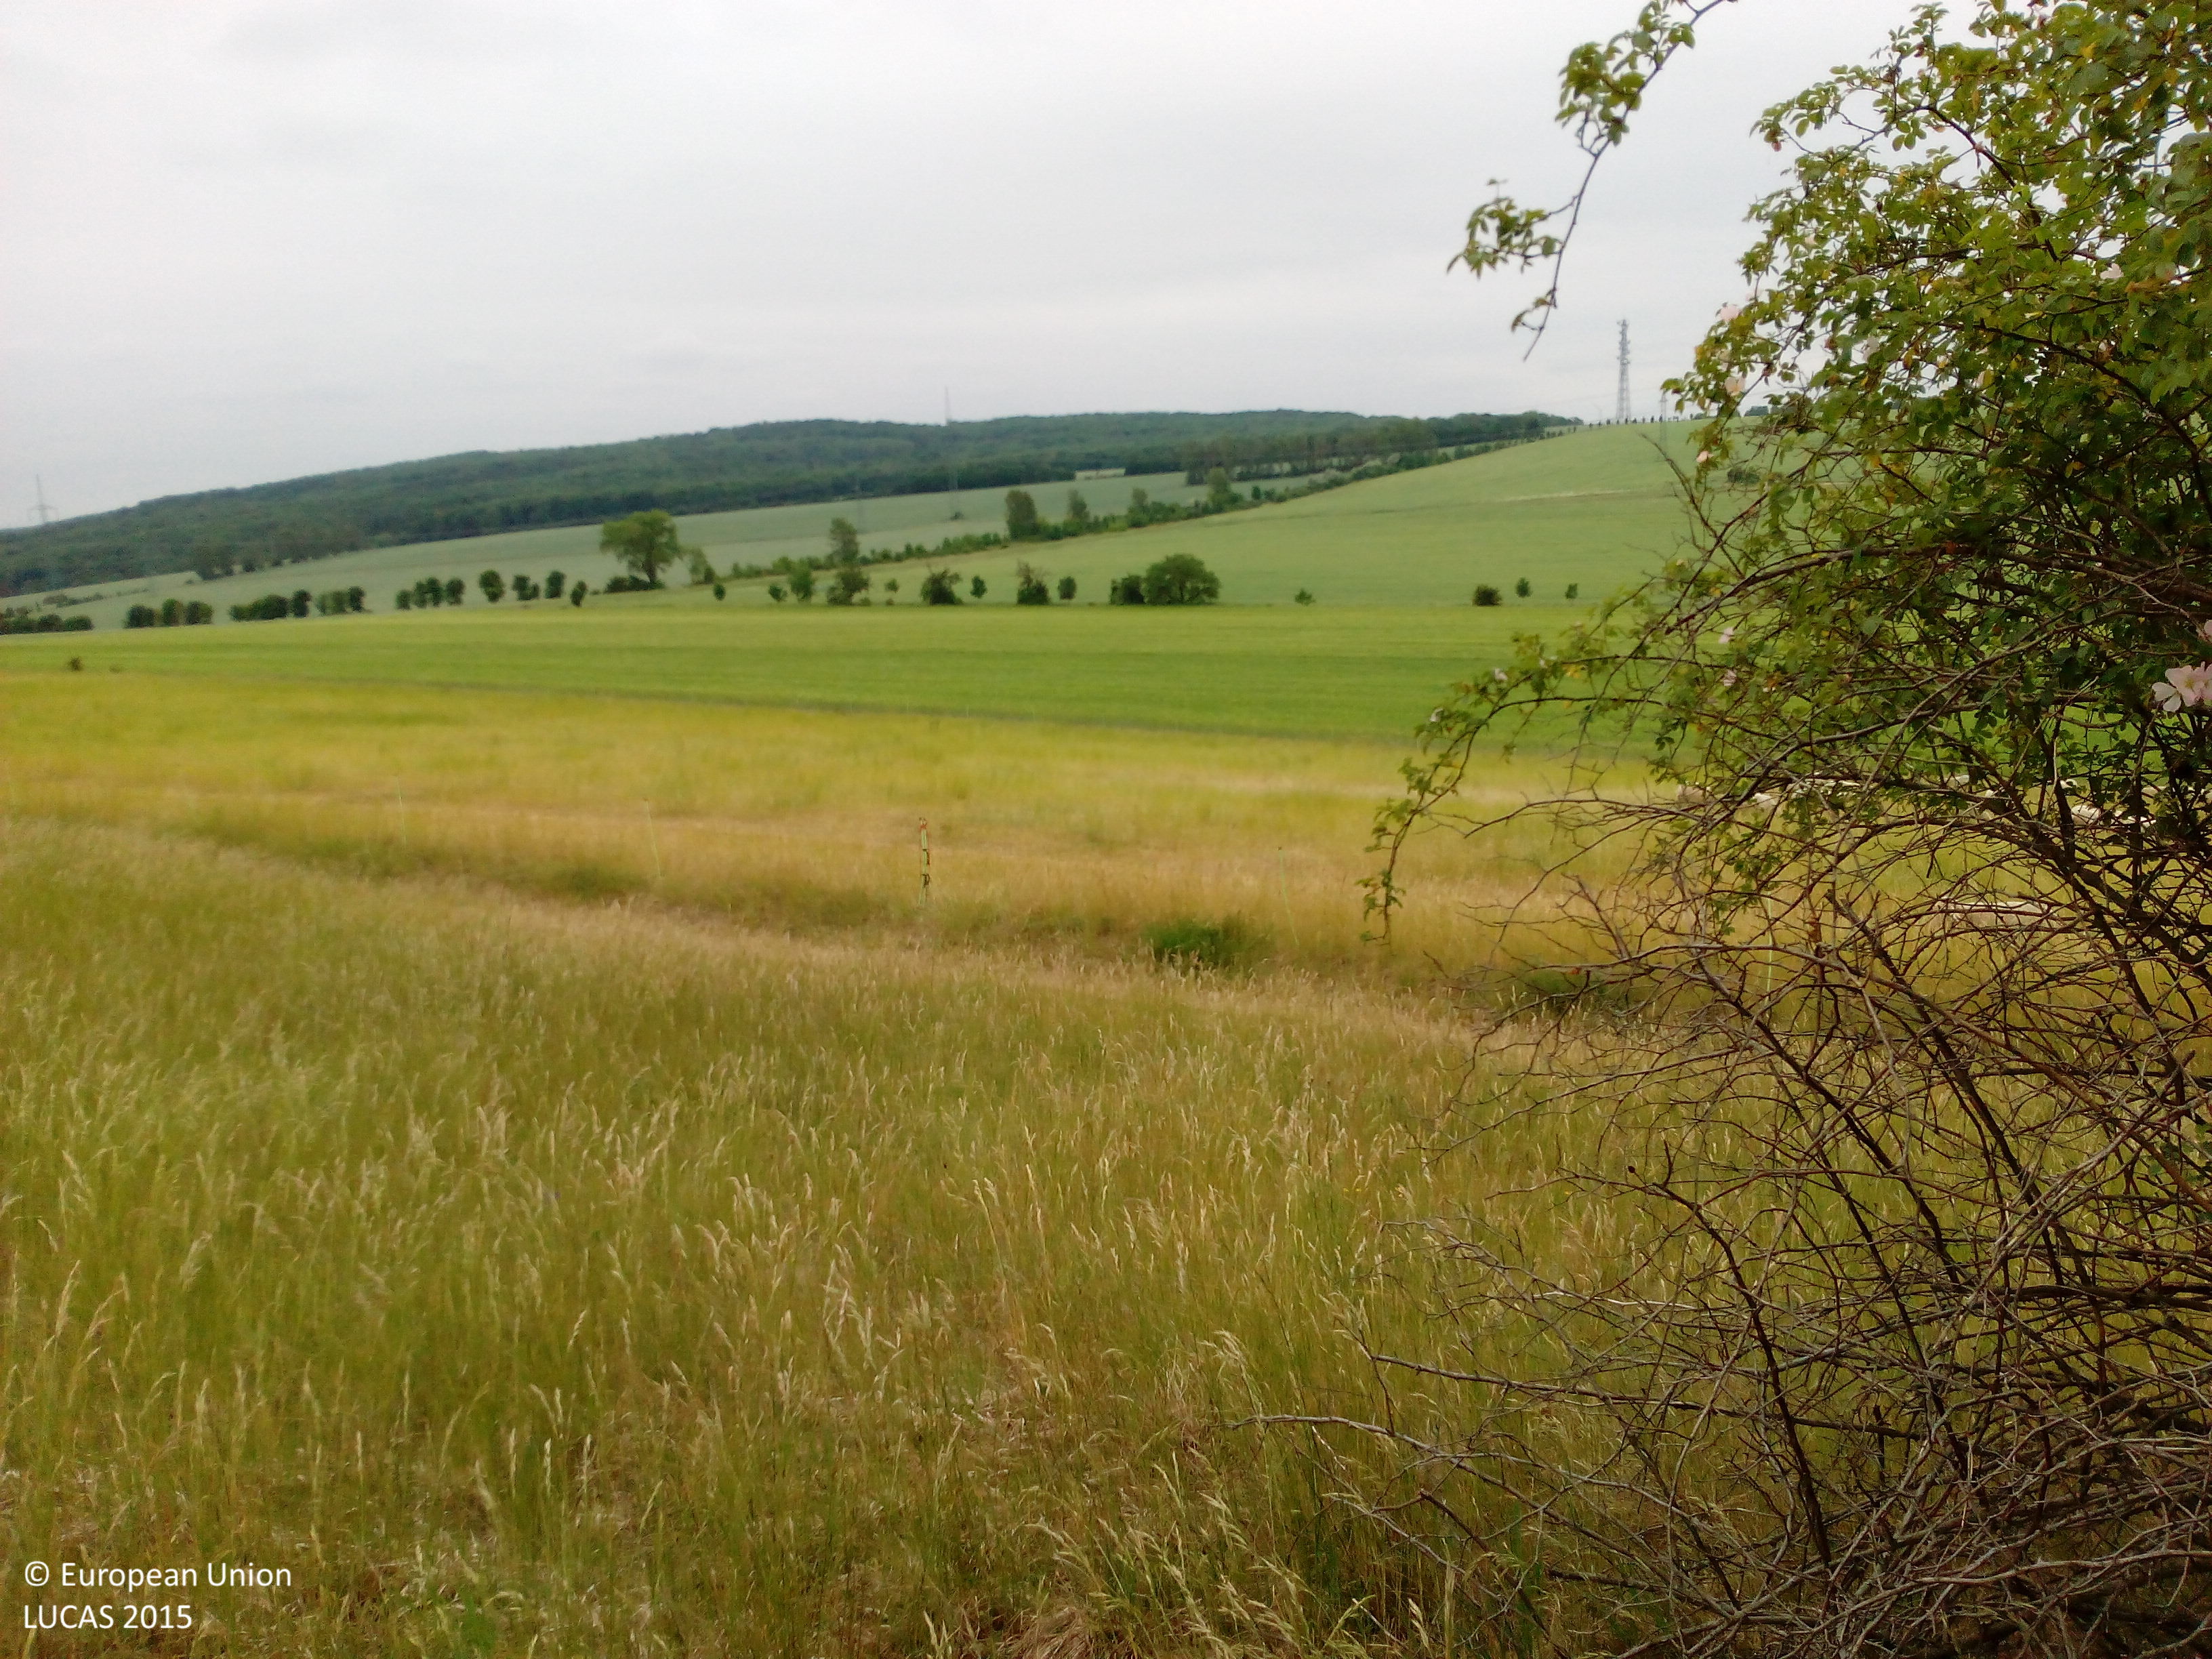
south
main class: Woodland
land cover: Spruce dominated coniferous woodland
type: hemiboreal forest and nemoral coniferous forest and mixed broadleaved-coniferous forest
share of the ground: 10 - 25 %
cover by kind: herbaceous plants 80 %, coniferous forest trees 15 %, shrubs 5 %
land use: Agriculture (excluding fallow land and kitchen gardens)
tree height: > 5 m
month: June
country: DE
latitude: 50.9915
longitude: 10.6409
